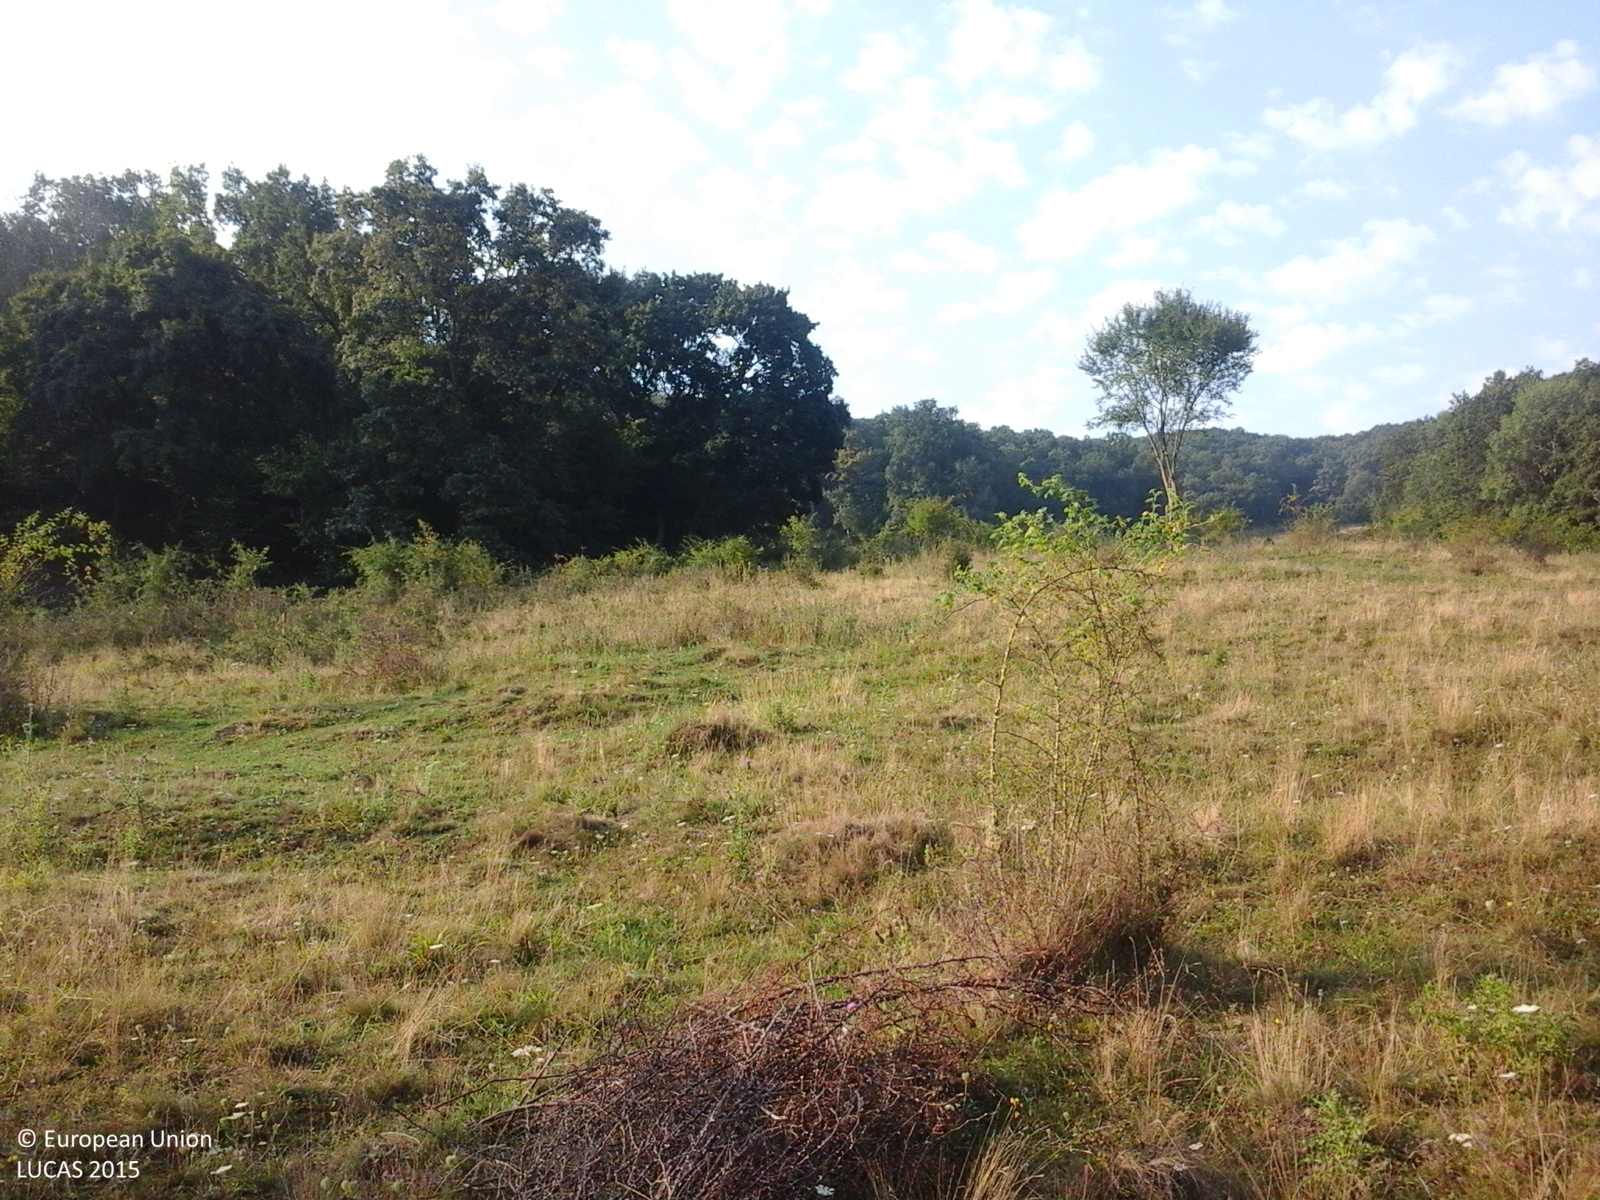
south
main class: Grassland
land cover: Grassland with sparse tree/shrub cover
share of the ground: > 75 %
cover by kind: herbaceous plants 95 %, broadleaved forest trees 5 %
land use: Fallow land
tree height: < 5 m
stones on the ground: < 10 %
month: September
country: RO
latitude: 47.0529
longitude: 24.5322
